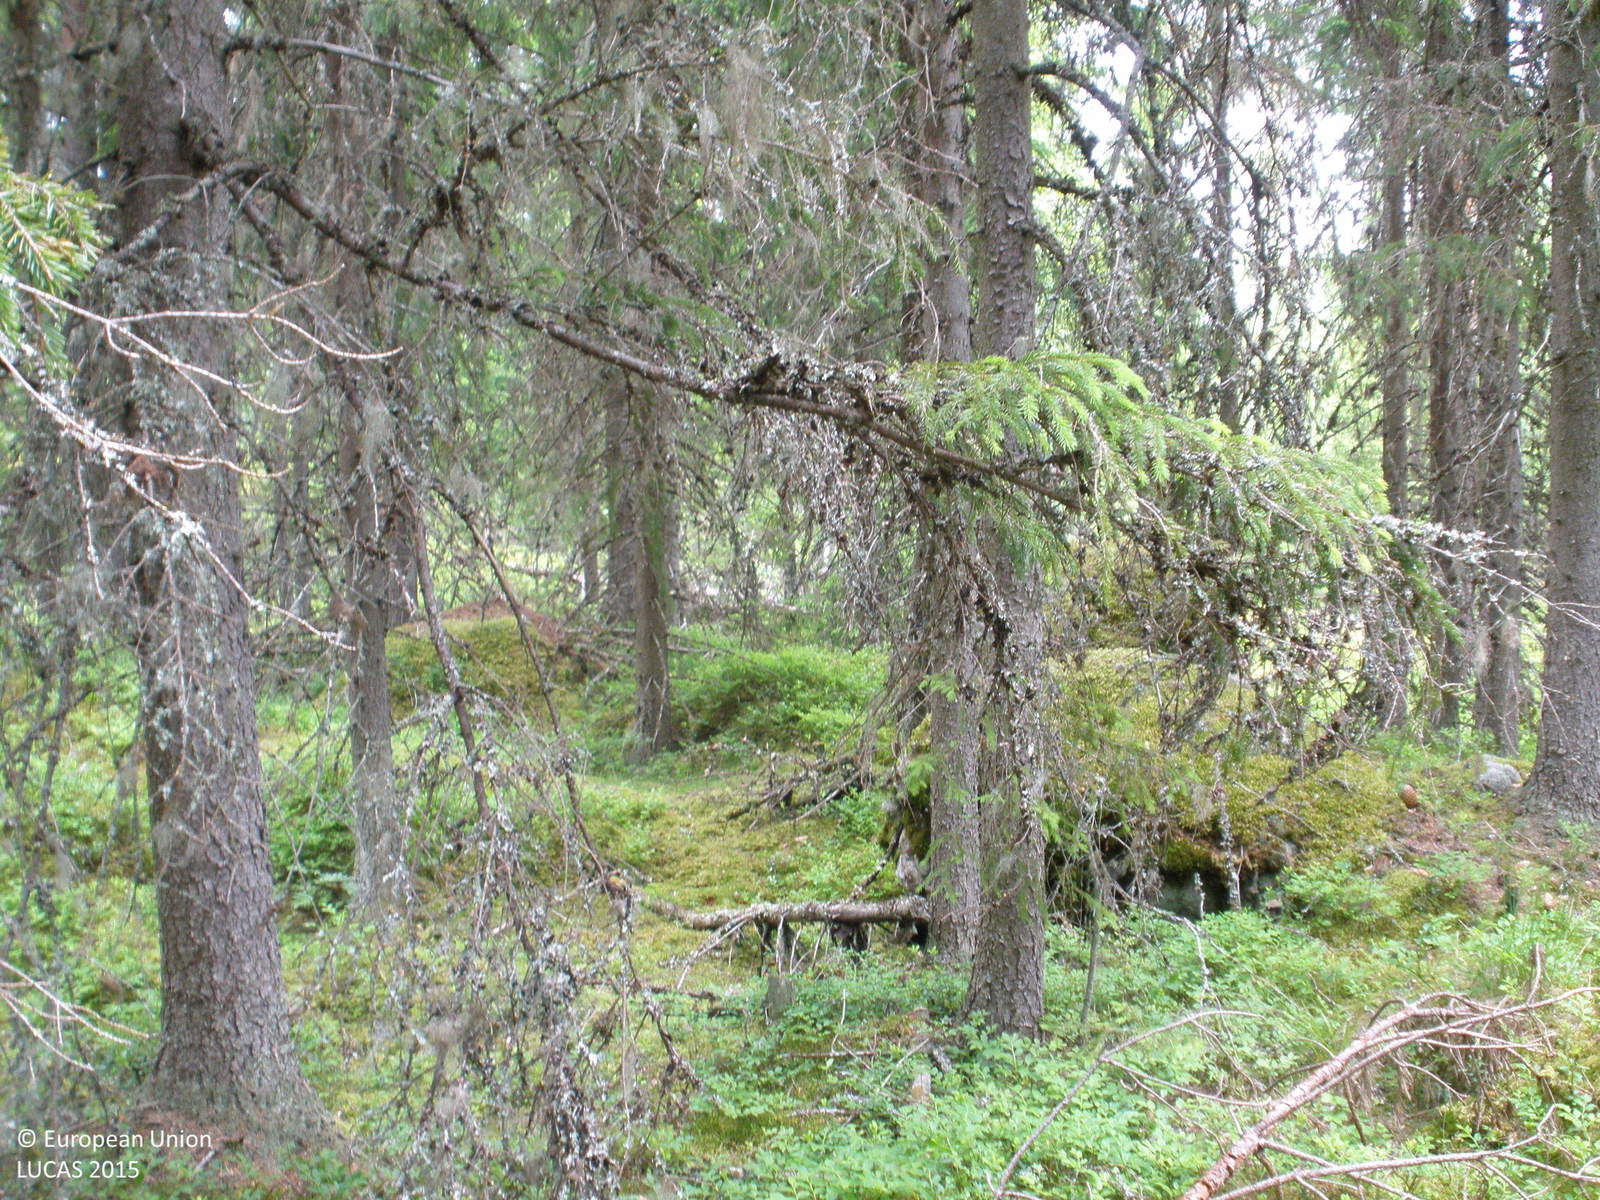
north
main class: Woodland
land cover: Spruce dominated coniferous woodland
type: boreal forest
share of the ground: > 75 %
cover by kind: coniferous forest trees 85 %, lichens and mosses 10 %, broadleaved forest trees 5 %
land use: Forestry
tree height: > 5 m
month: June
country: FI
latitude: 61.3308
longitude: 24.5447
